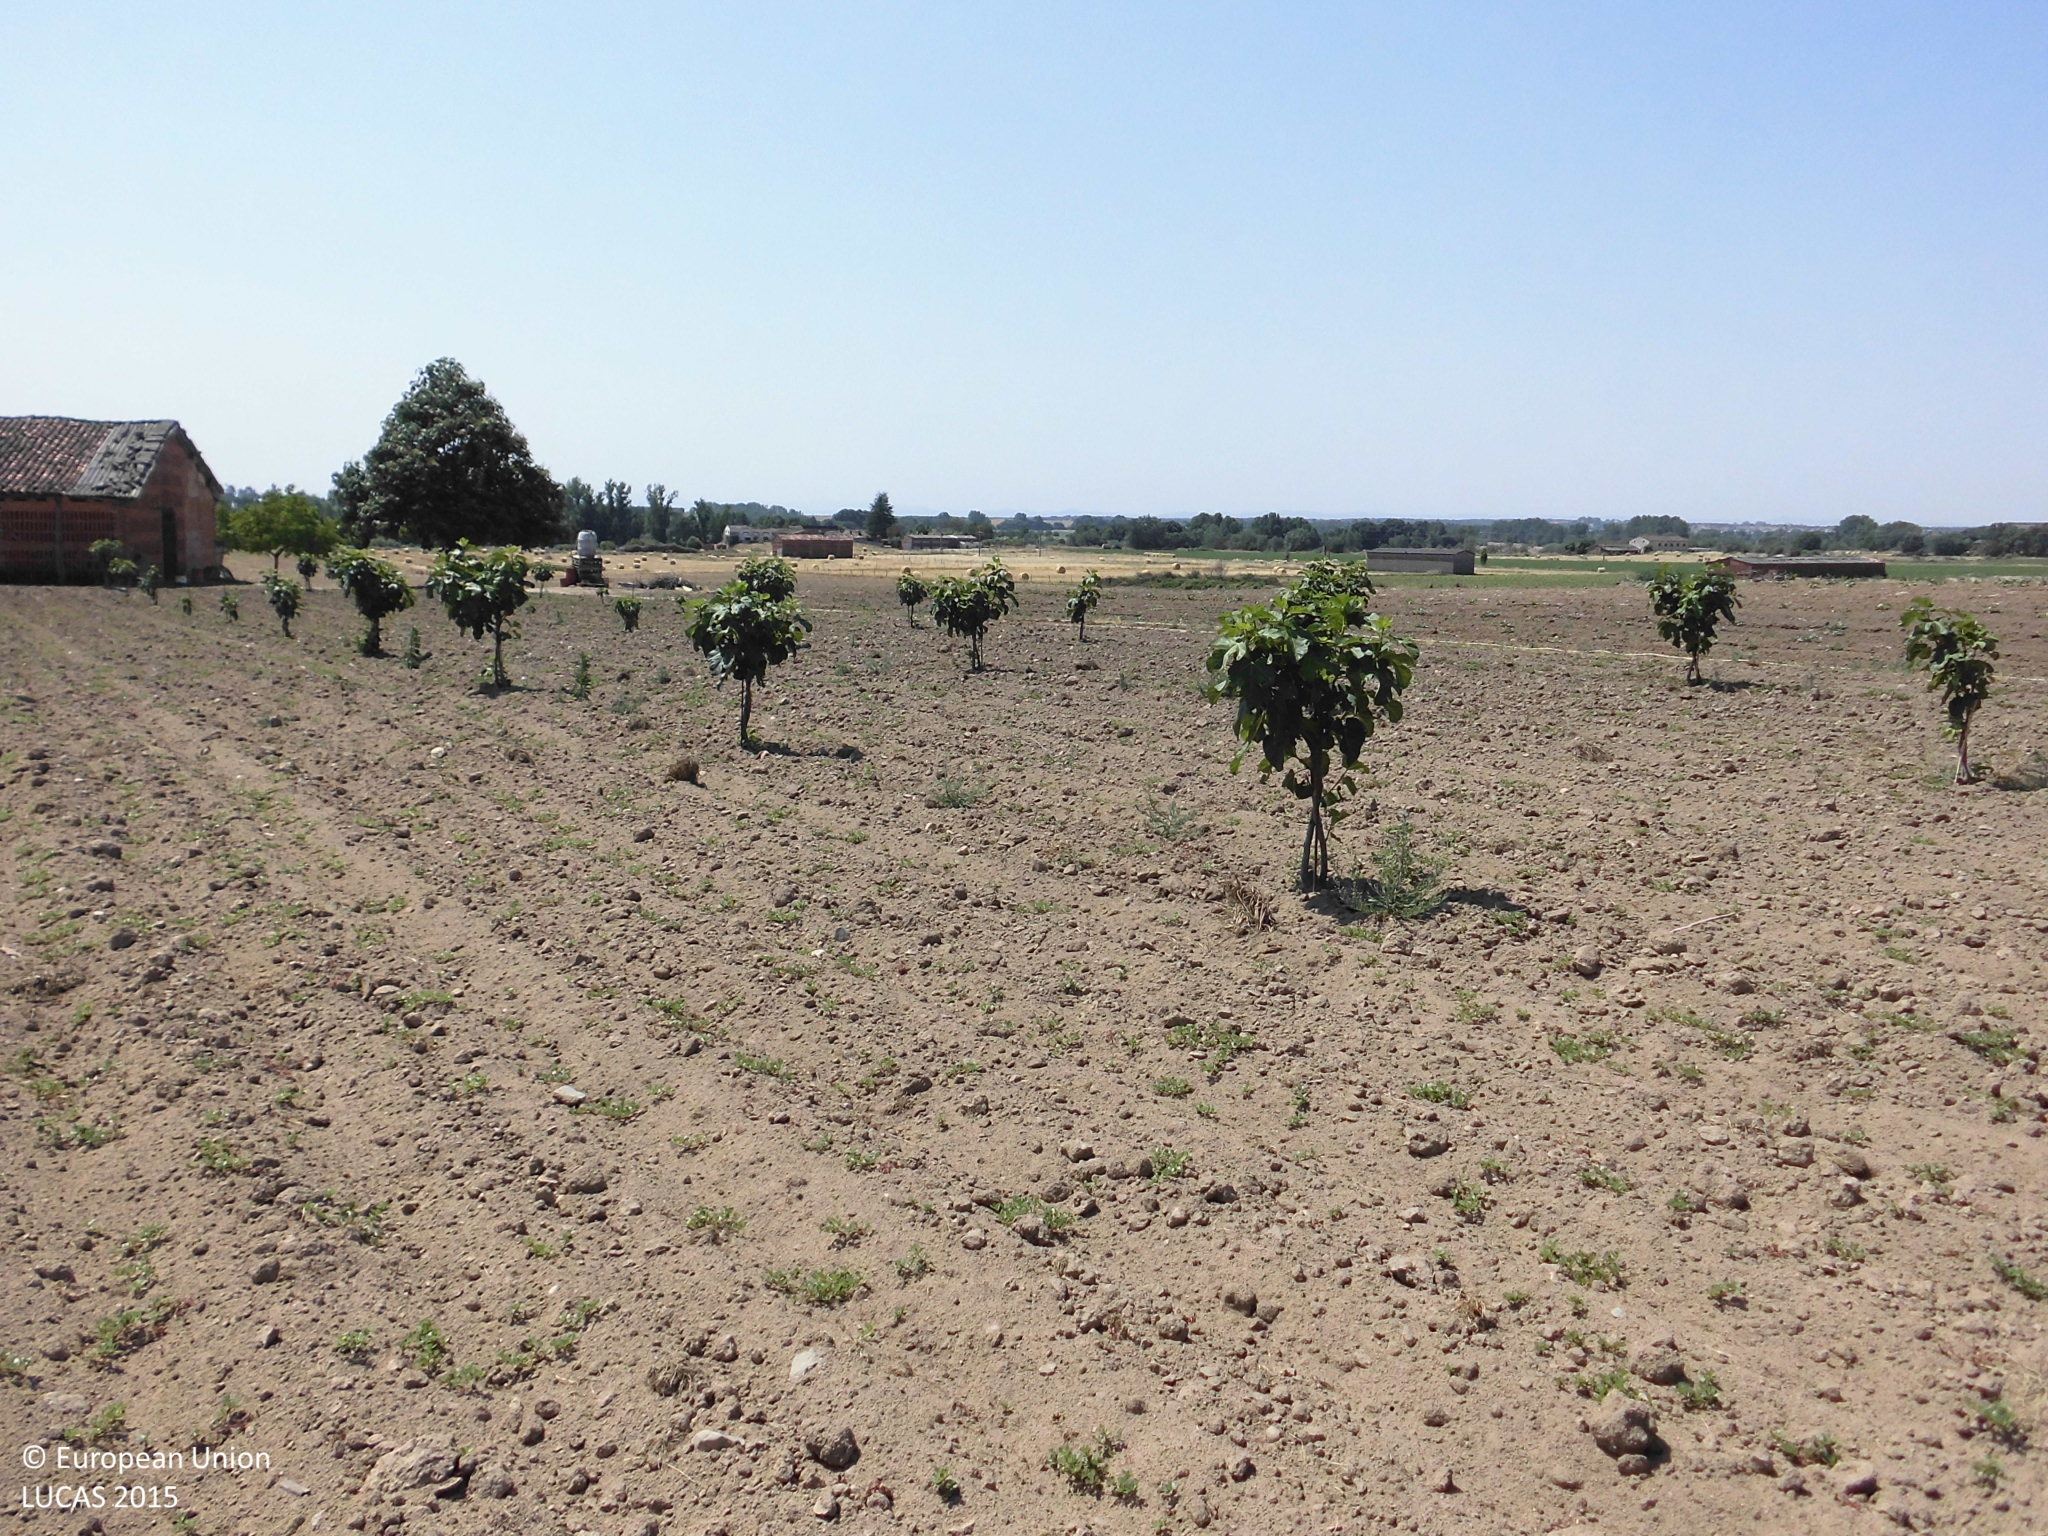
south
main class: Cropland
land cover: Other fruit trees and berries
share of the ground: < 10 %
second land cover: Other bare soil
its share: > 75 %
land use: Agriculture (excluding fallow land and kitchen gardens)
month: June
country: ES
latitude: 40.0742
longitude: -5.5041
